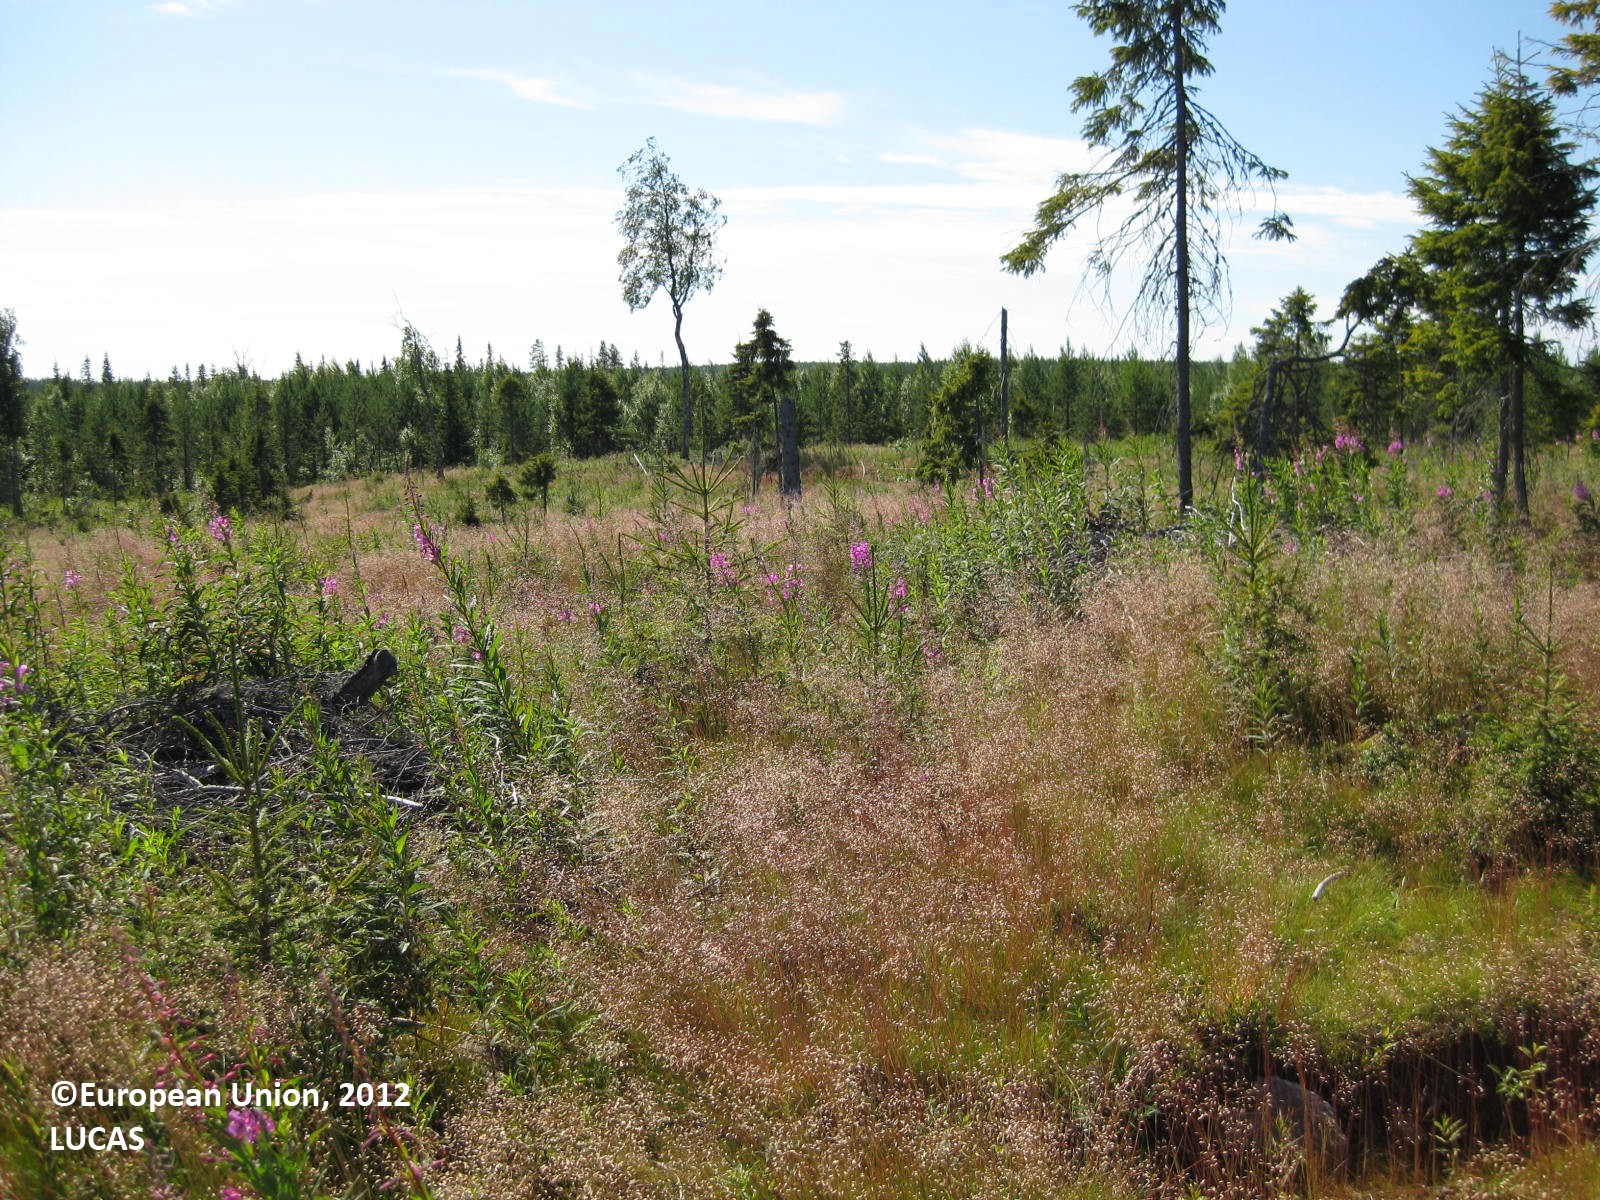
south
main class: Woodland
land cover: Spruce dominated coniferous woodland
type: boreal forest
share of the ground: 10 - 25 %
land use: Forestry
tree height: < 5 m
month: July
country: FI
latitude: 65.5995
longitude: 28.4461
